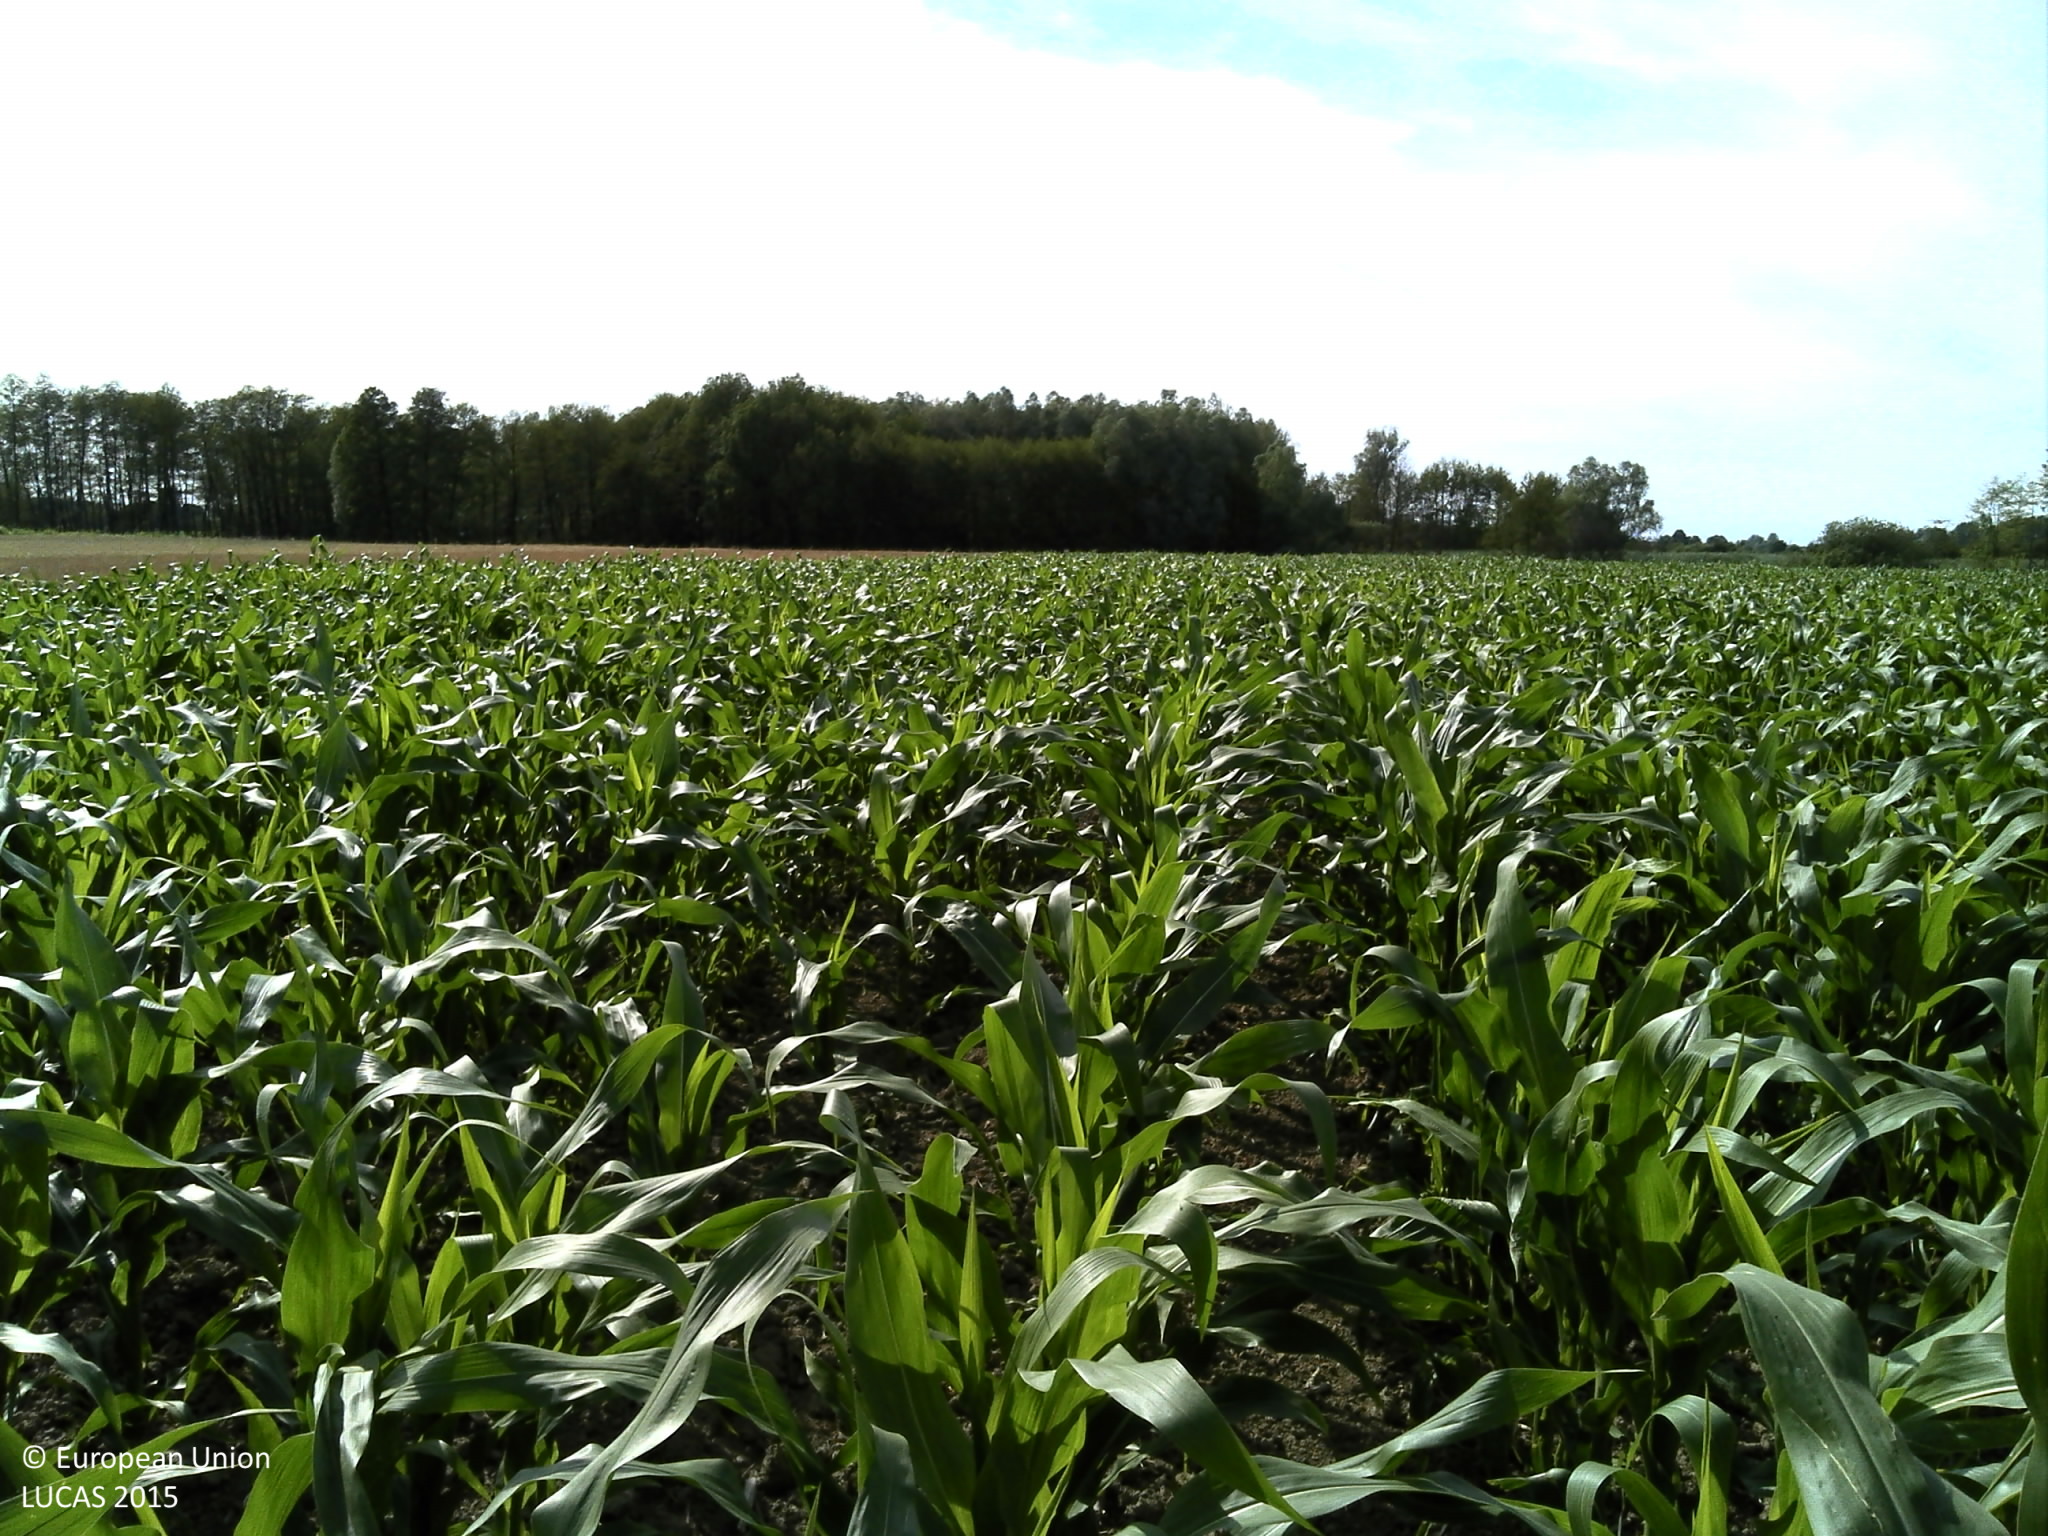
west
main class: Cropland
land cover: Maize
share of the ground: > 75 %
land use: Agriculture (excluding fallow land and kitchen gardens)
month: June
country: HR
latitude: 45.9037
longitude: 17.5438
